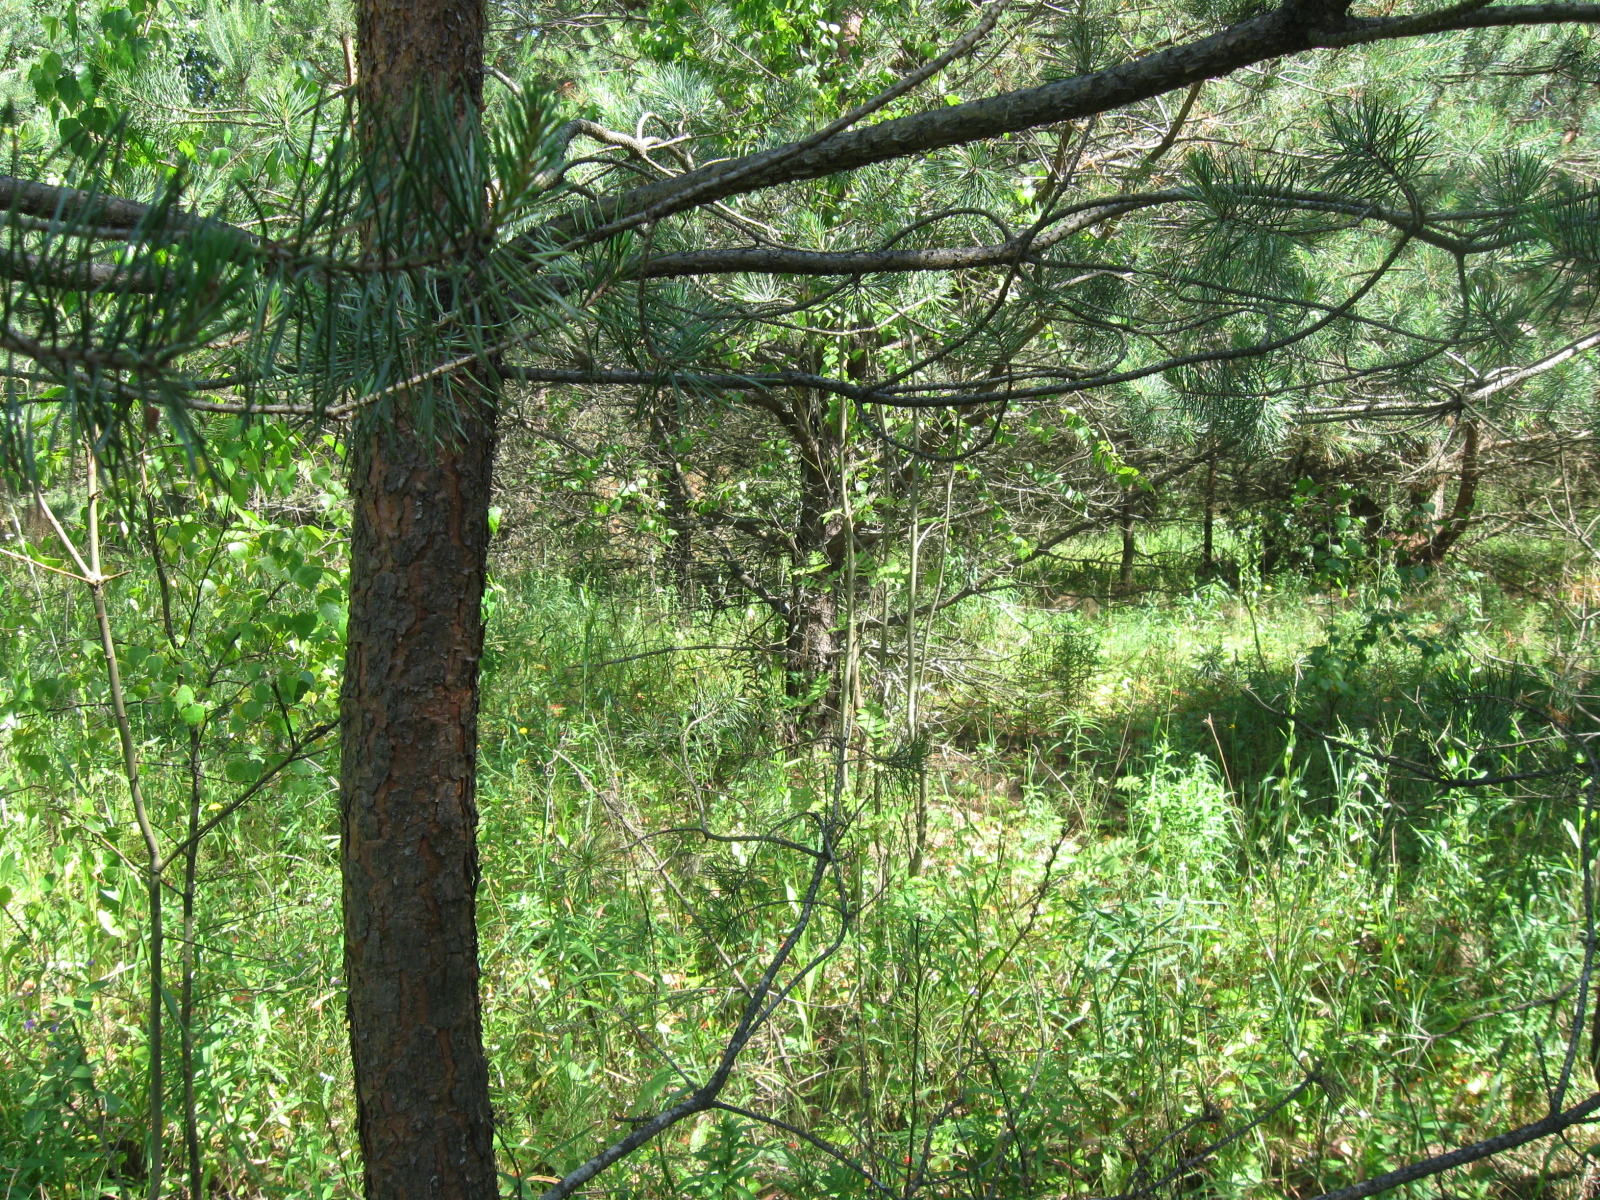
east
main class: Woodland
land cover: Pine dominated mixed woodland
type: hemiboreal forest and nemoral coniferous forest and mixed broadleaved-coniferous forest
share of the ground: > 75 %
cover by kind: coniferous forest trees 50 %, broadleaved forest trees 30 %, herbaceous plants 20 %
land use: Forestry
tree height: > 5 m
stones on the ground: < 10 %
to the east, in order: Pine dominated mixed woodland; Rape and turnip rape; Pine dominated mixed woodland
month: July
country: LT
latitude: 54.2126
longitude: 24.2827
